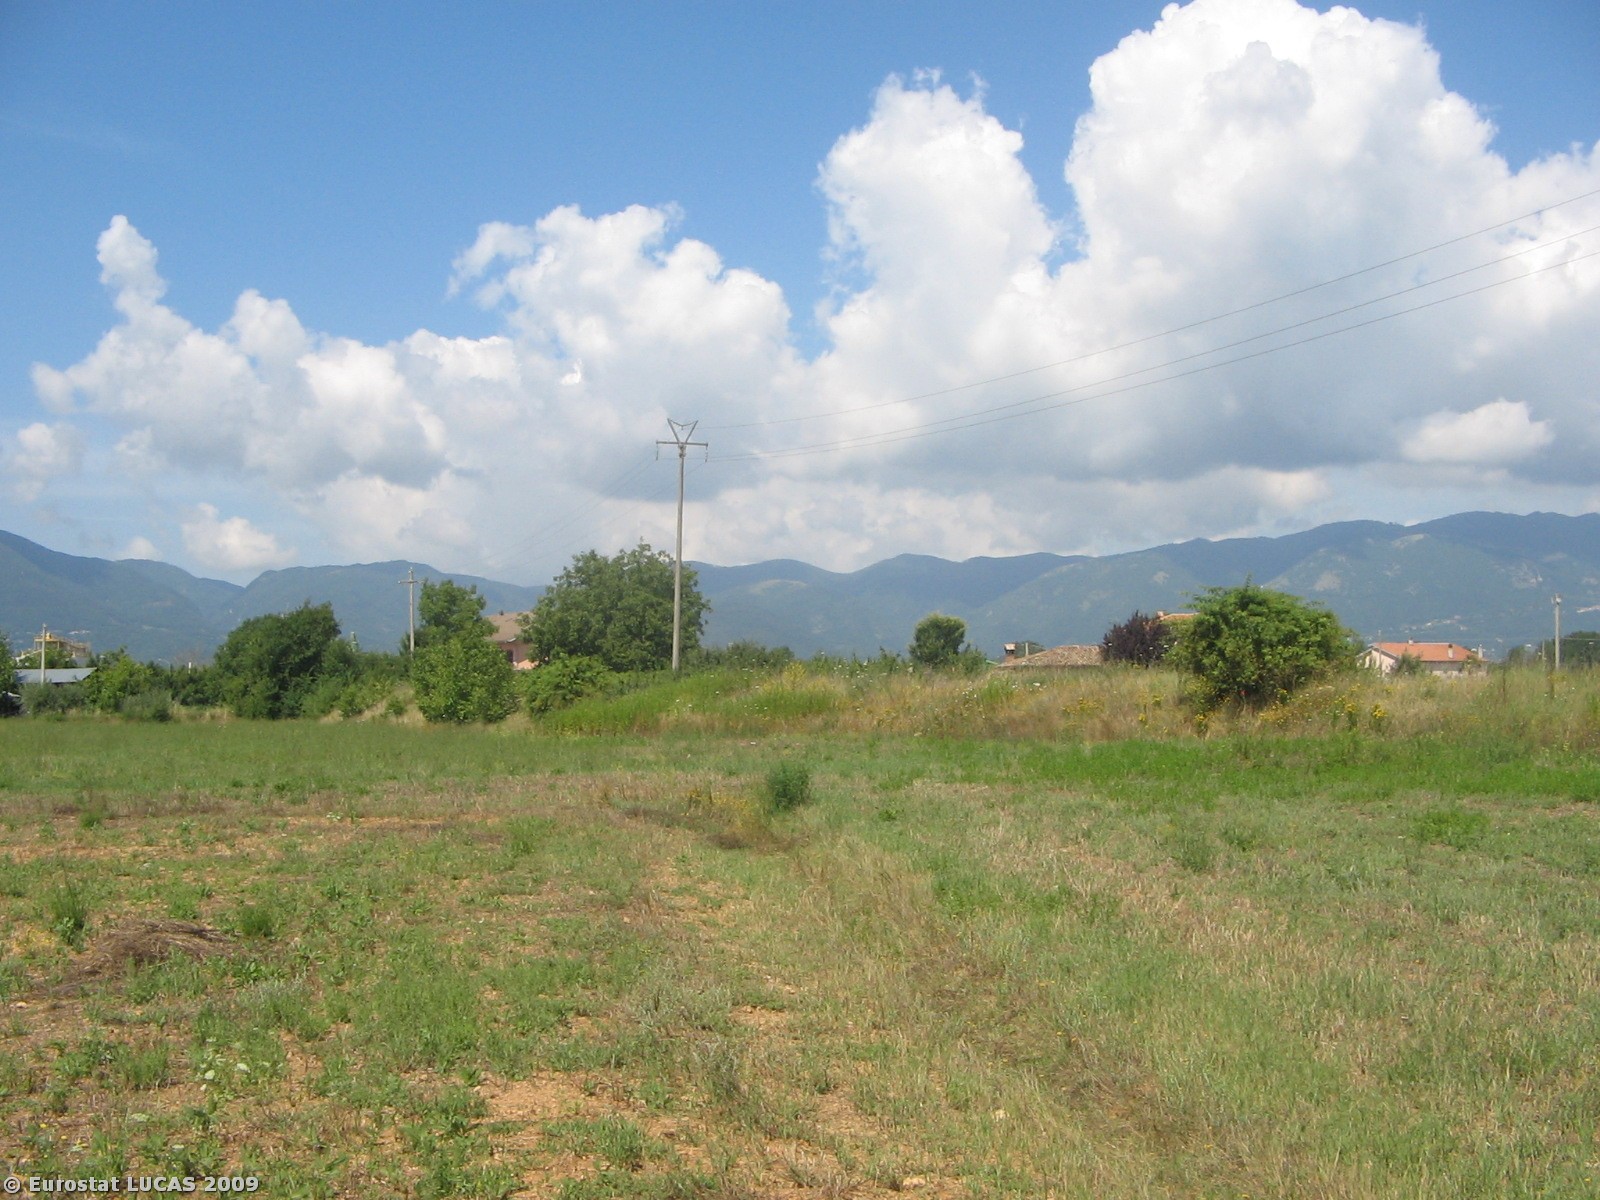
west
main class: Grassland
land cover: Spontaneously vegetated surfaces
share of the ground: > 75 %
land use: Fallow land
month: July
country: IT
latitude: 42.4152
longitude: 12.8464
